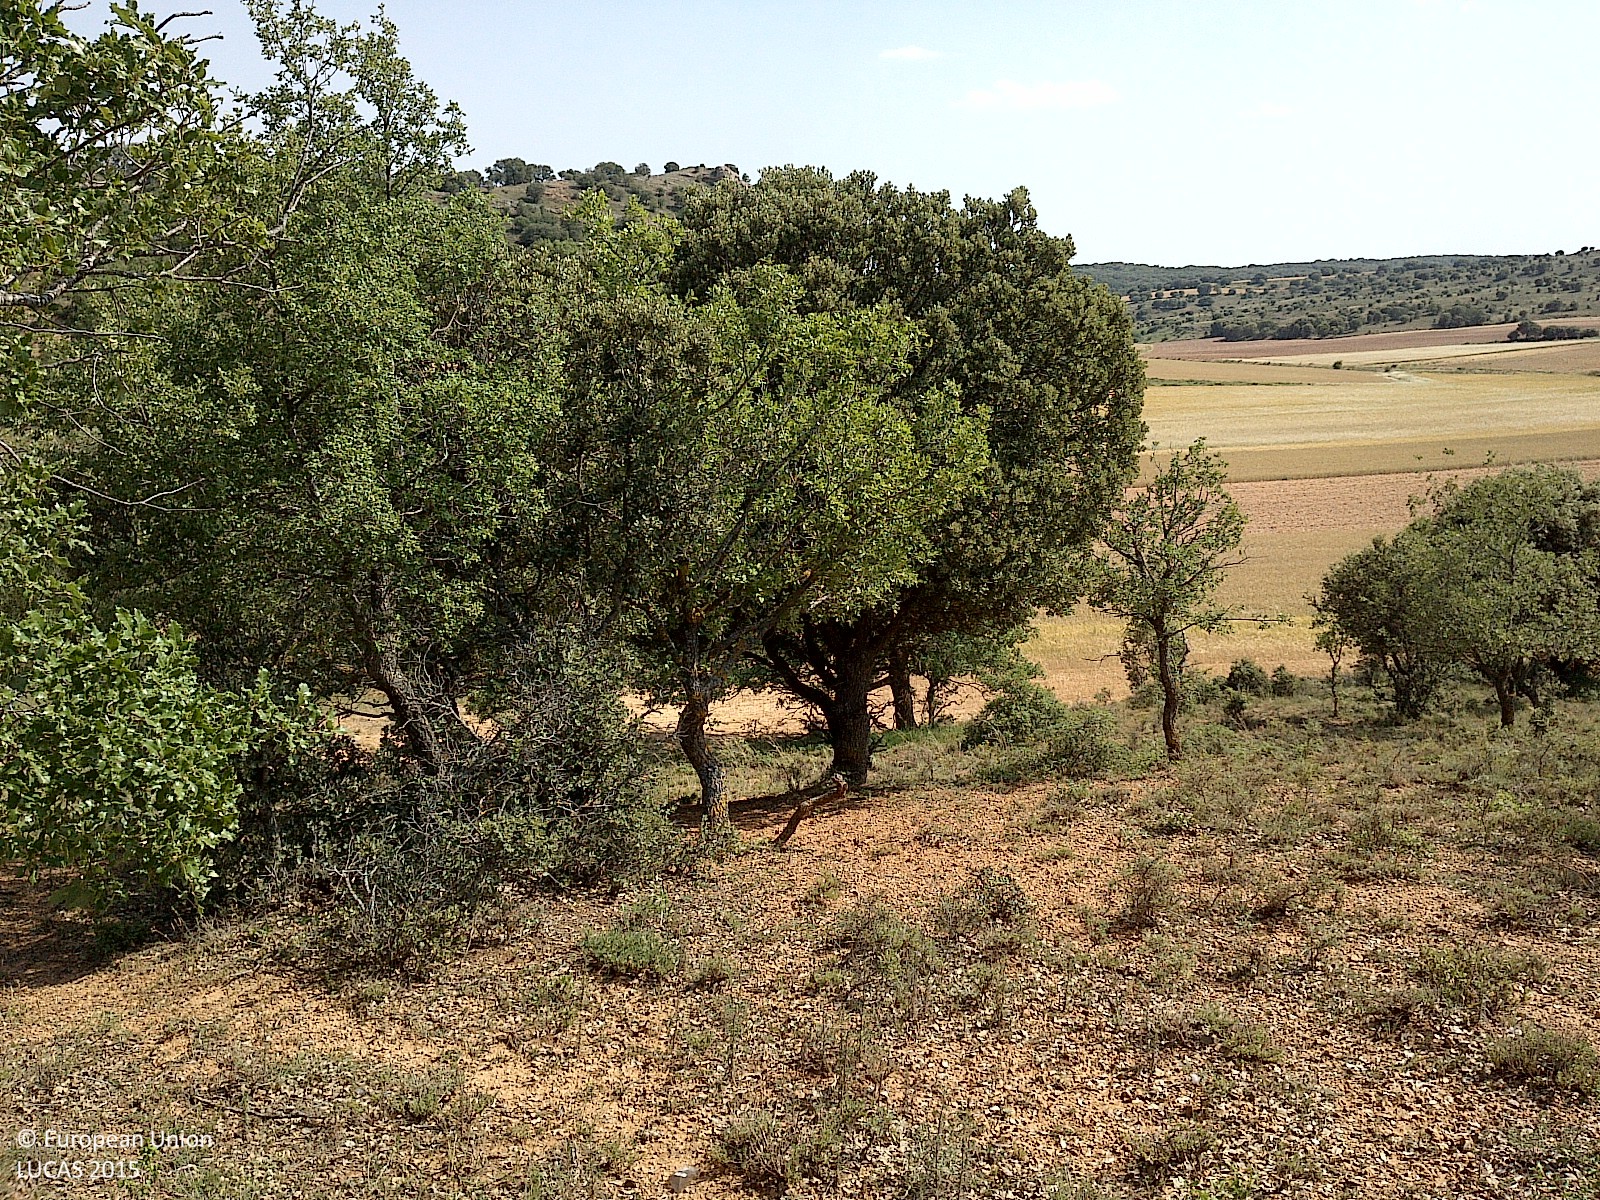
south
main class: Woodland
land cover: Broadleaved woodland
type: broadleaved evergreen forest
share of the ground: 25 - 50 %
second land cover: Grassland without tree/shrub cover
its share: 50 - 75 %
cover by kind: herbaceous plants 50 %, broadleaved forest trees 30 %, shrubs 10 %, unconsolidated bare surface 10 %
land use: Forestry
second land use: Agriculture (excluding fallow land and kitchen gardens)
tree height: < 5 m
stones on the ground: < 10 %
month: June
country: ES
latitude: 41.5426
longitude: -2.2483
